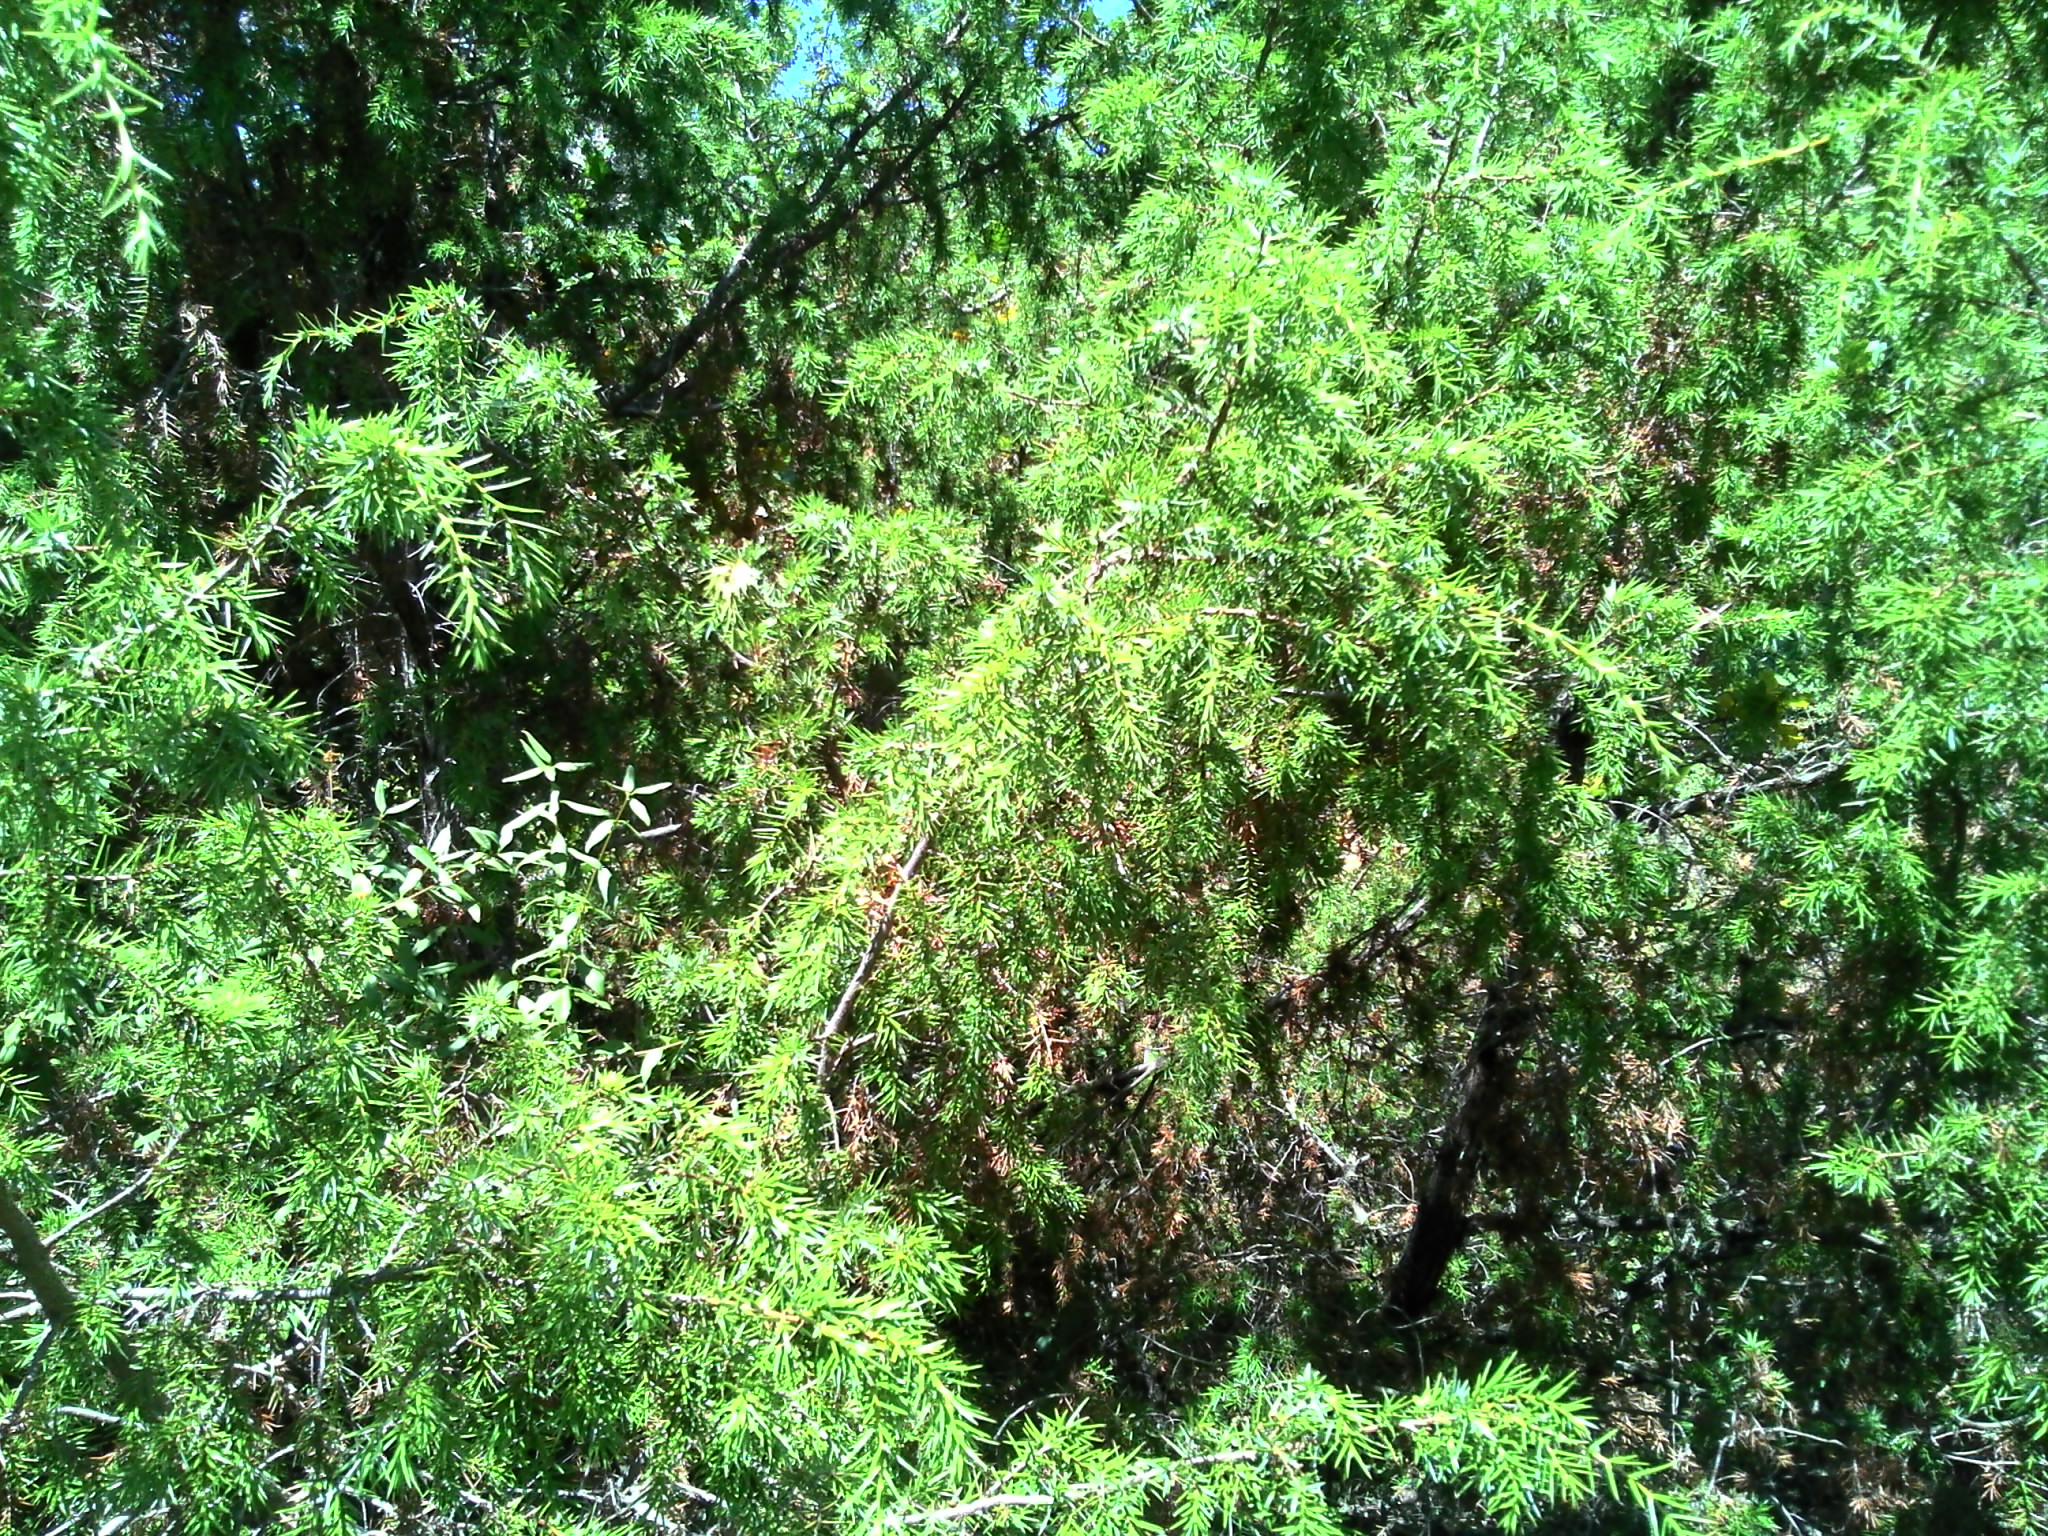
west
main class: Woodland
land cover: Other mixed woodland
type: broadleaved evergreen forest
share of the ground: > 75 %
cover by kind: broadleaved forest trees 50 %, coniferous forest trees 25 %, shrubs 20 %, herbaceous plants 5 %
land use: Semi-natural and natural areas not in use
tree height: > 5 m
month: July
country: FR
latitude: 44.1781
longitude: 4.3413
